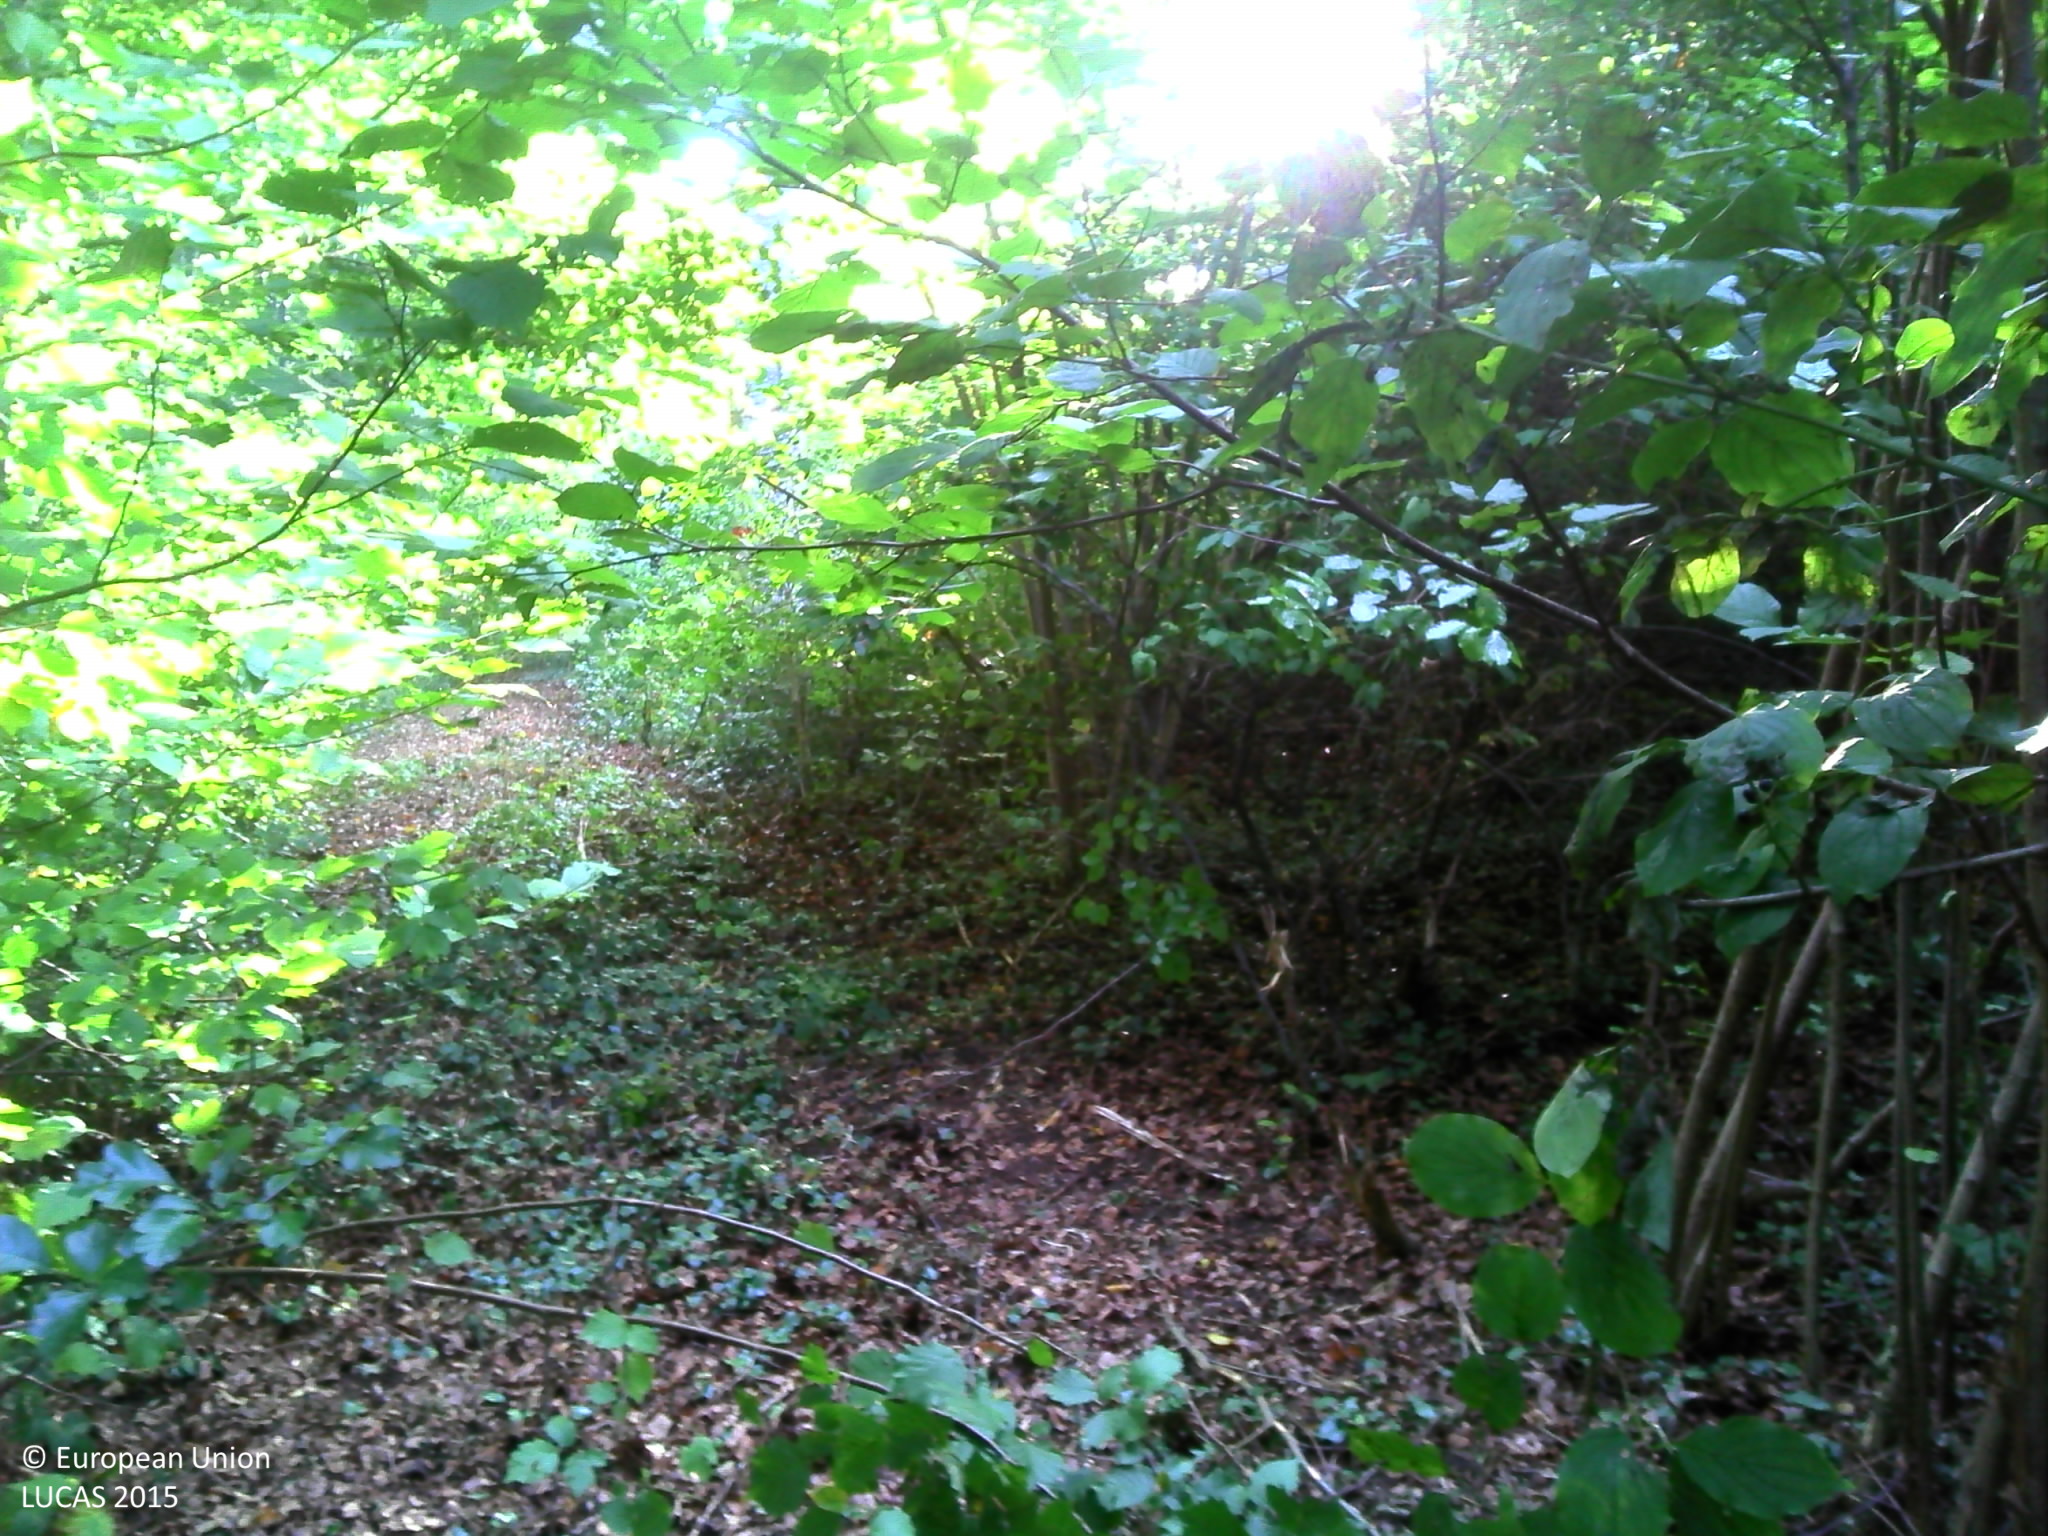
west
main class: Woodland
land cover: Broadleaved woodland
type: beech forest
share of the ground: > 75 %
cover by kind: broadleaved forest trees 90 %, consolidated bare surface 5 %
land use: Forestry
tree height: > 5 m
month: September
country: FR
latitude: 47.2449
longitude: 6.3687
